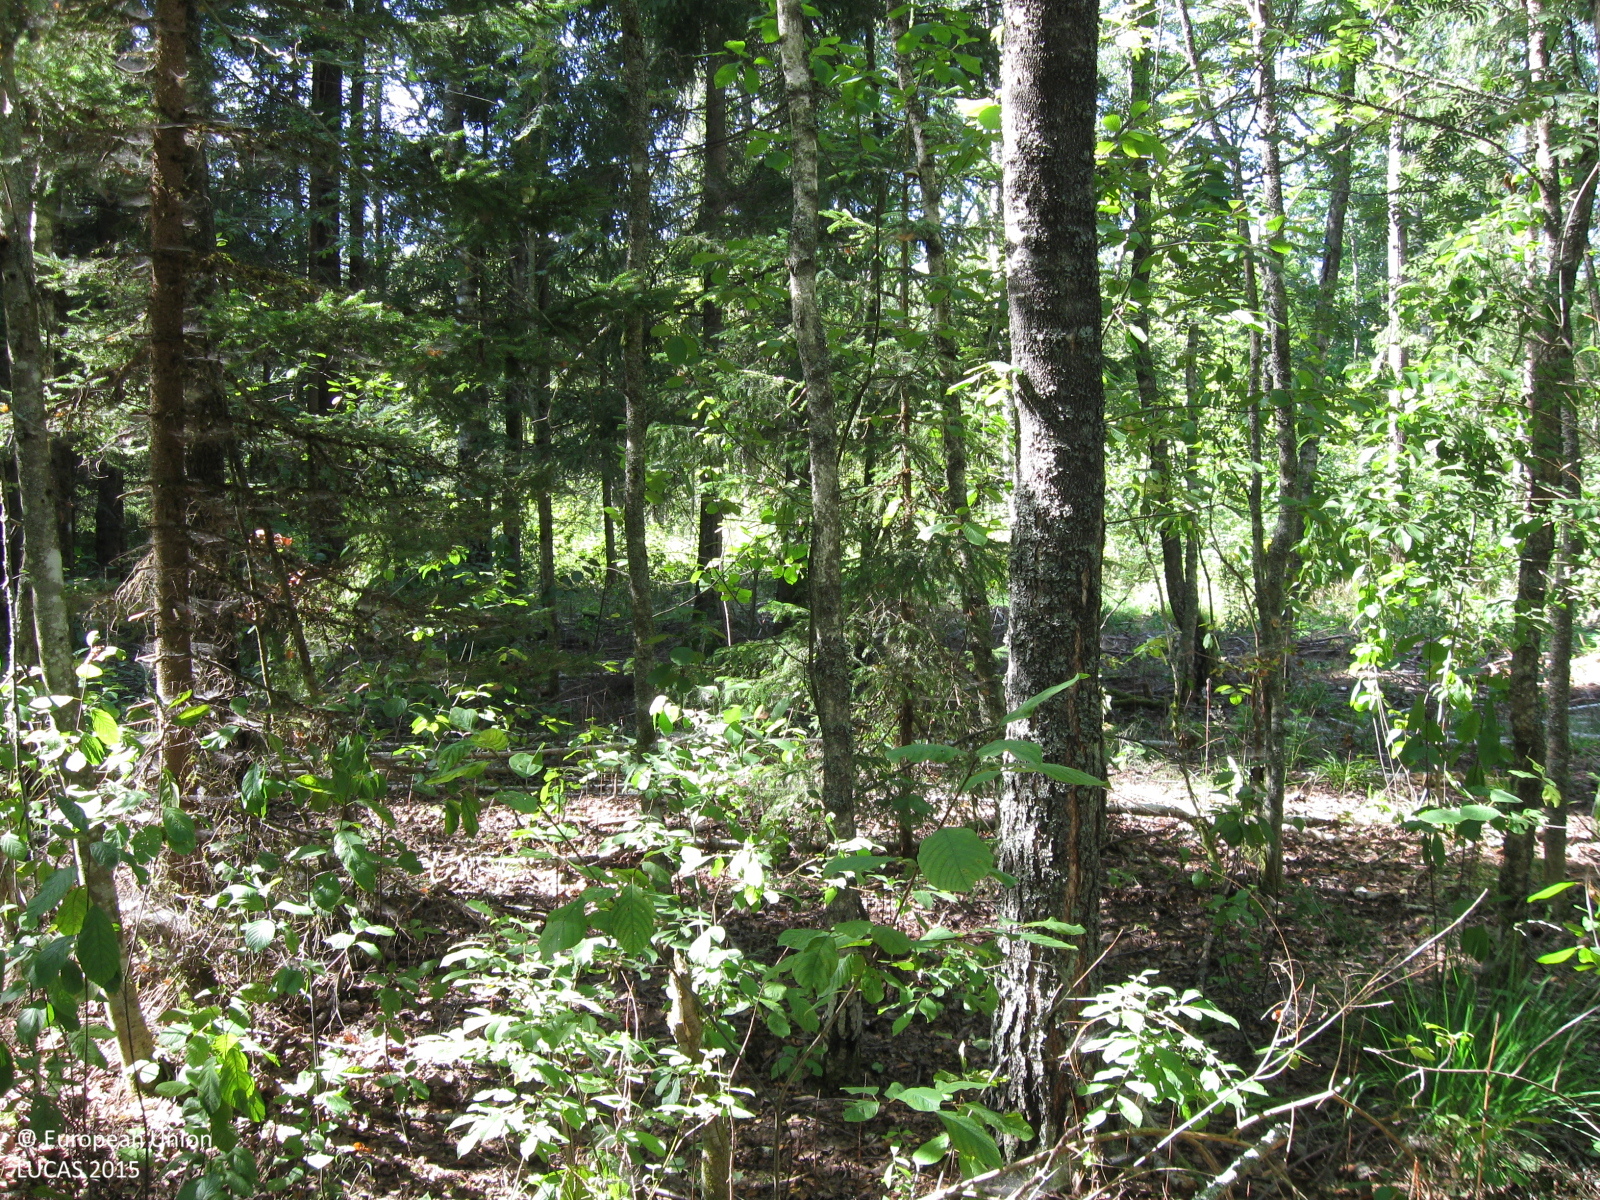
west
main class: Woodland
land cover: Other mixed woodland
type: hemiboreal forest and nemoral coniferous forest and mixed broadleaved-coniferous forest
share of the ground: > 75 %
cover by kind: broadleaved forest trees 65 %, coniferous forest trees 30 %, herbaceous plants 5 %
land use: Forestry
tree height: > 5 m
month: August
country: LT
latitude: 55.5838
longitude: 22.5791
